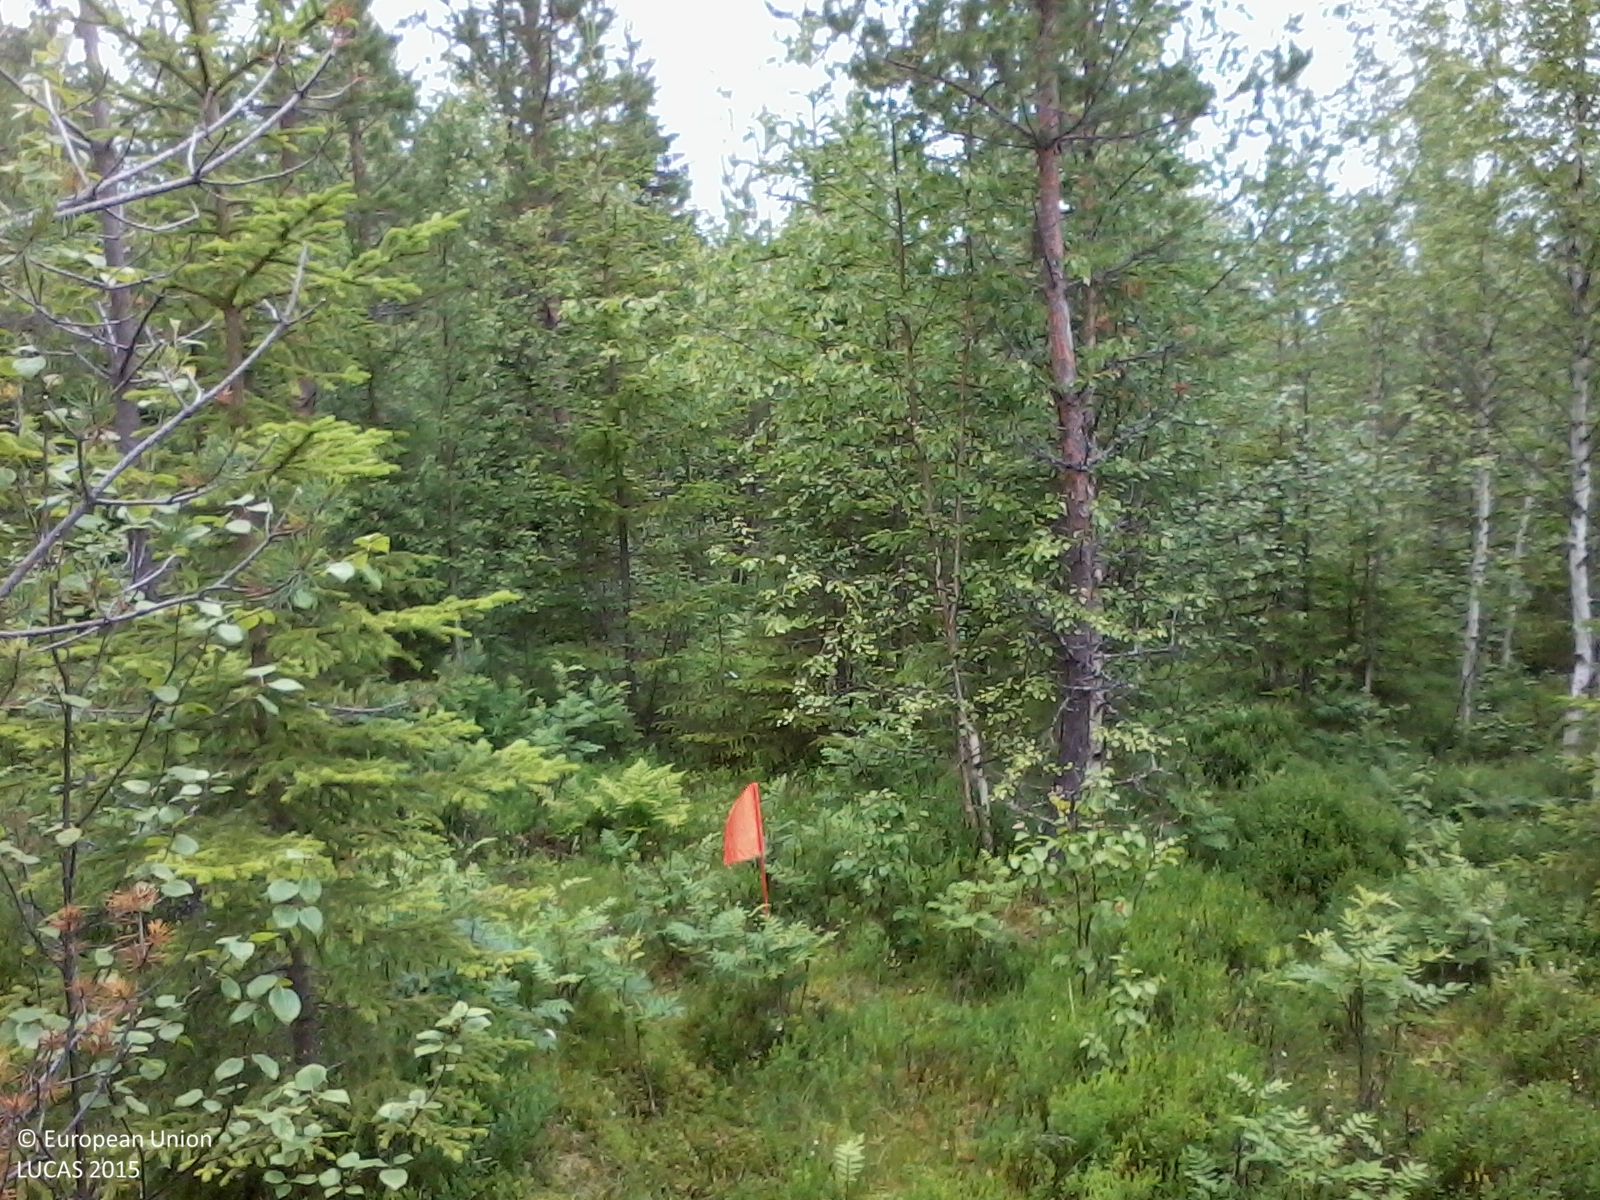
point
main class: Woodland
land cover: Pine dominated mixed woodland
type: boreal forest
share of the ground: 50 - 75 %
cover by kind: coniferous forest trees 50 %, broadleaved forest trees 20 %, shrubs 15 %, herbaceous plants 10 %, lichens and mosses 5 %
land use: Forestry
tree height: < 5 m
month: July
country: SE
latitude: 63.5521
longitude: 18.1654
